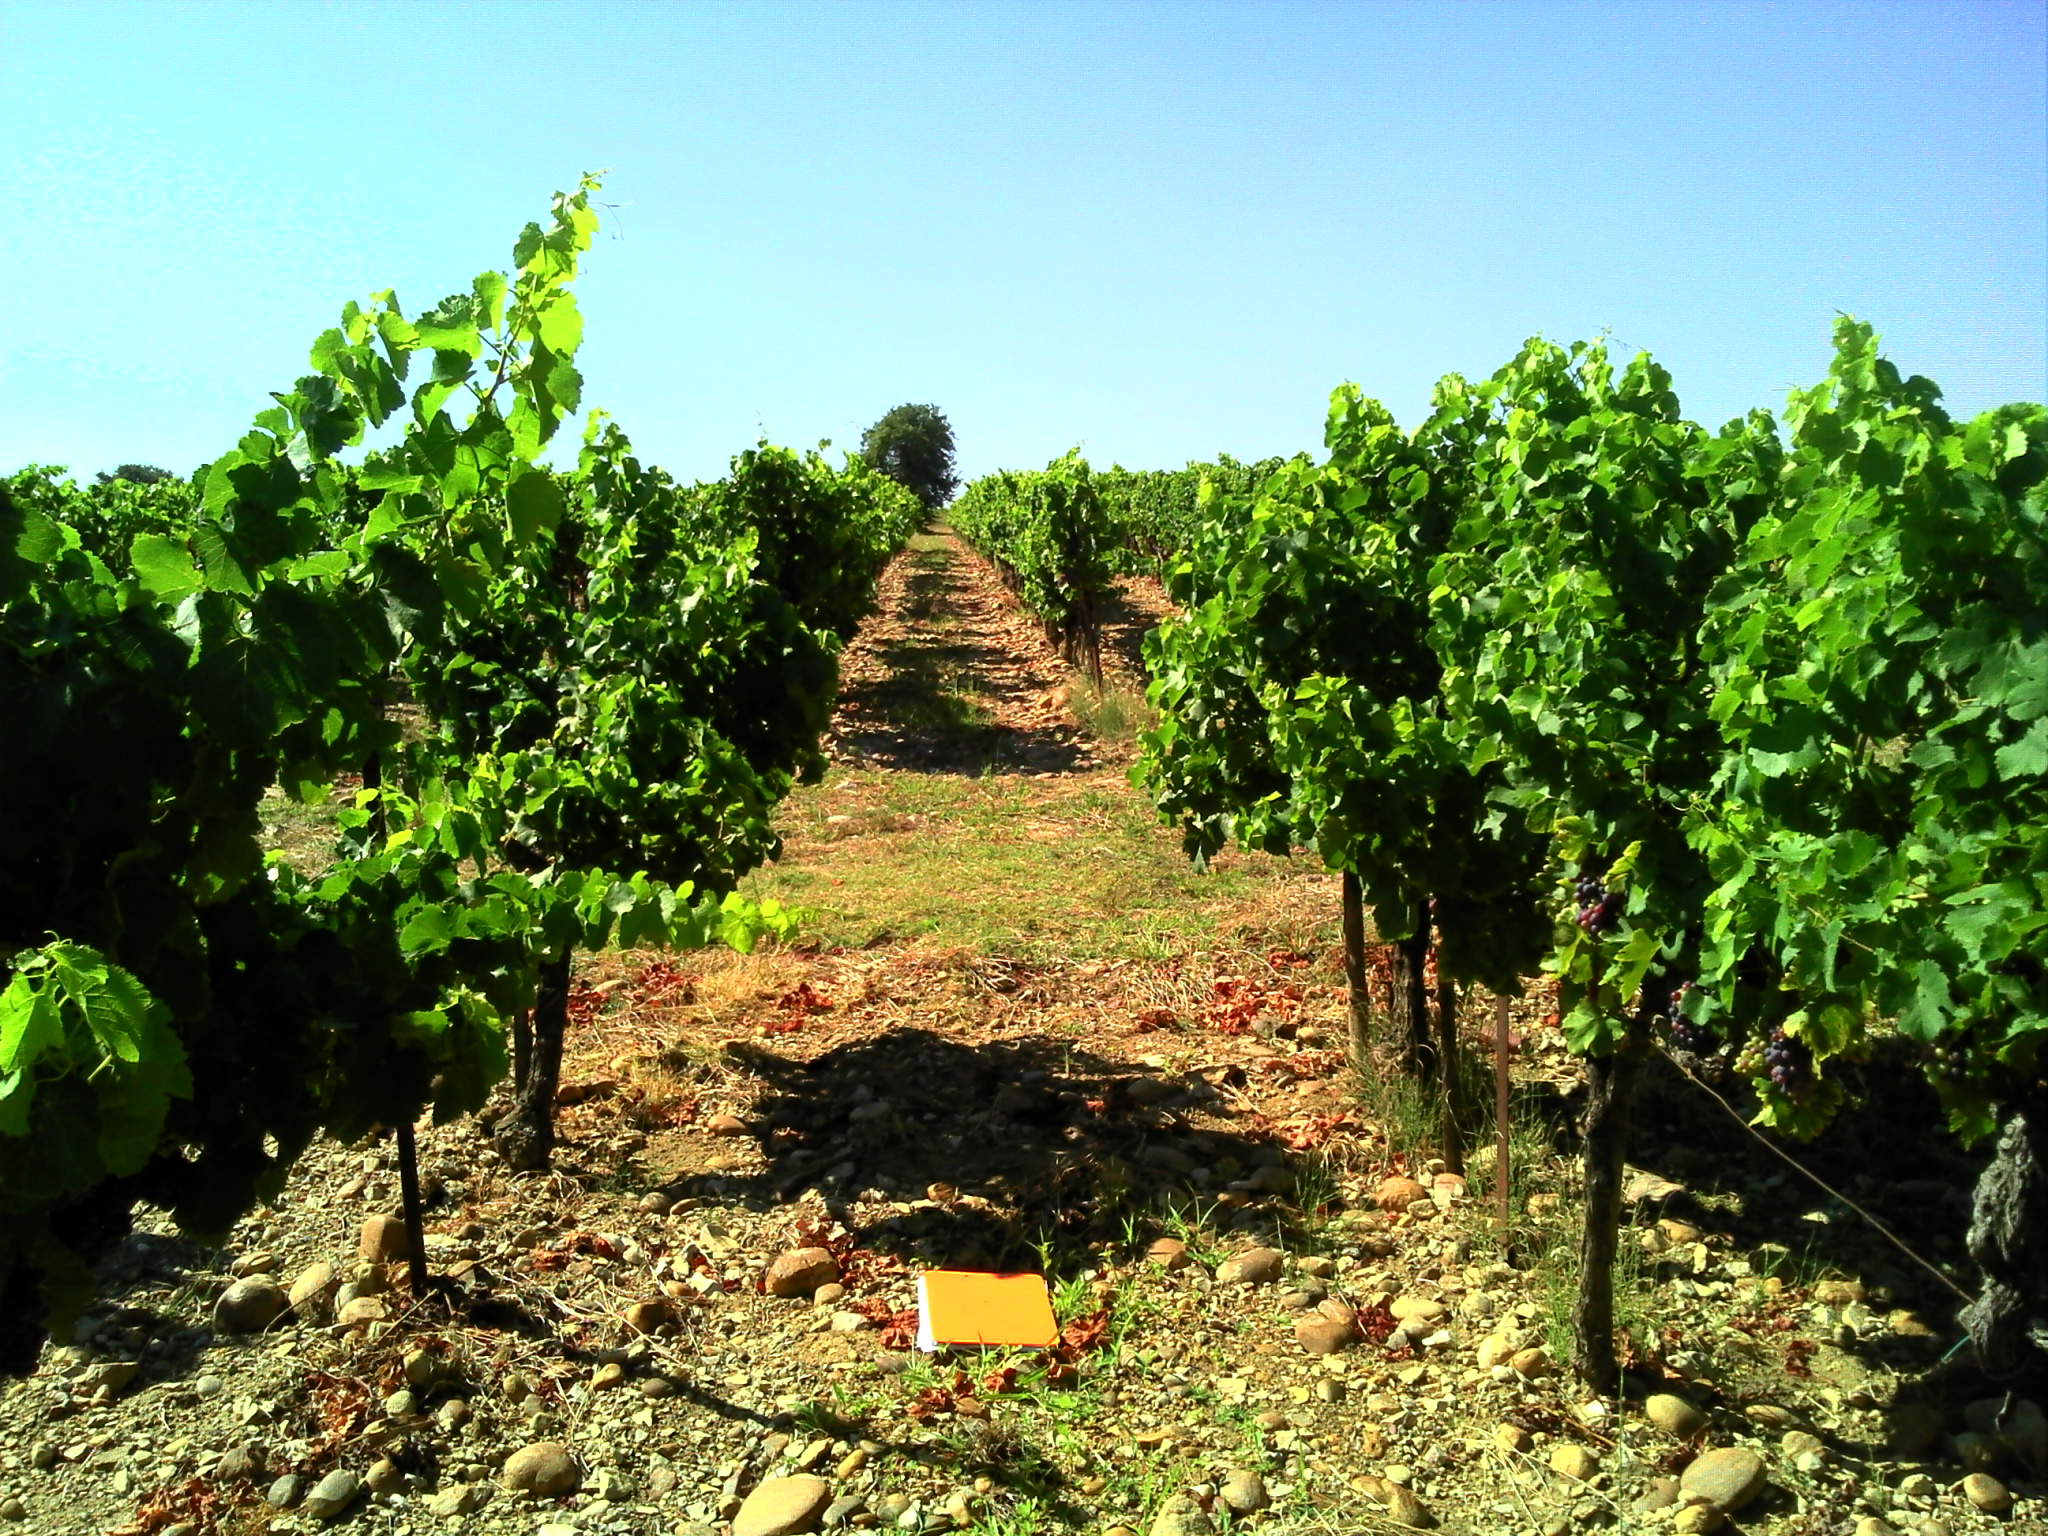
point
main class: Cropland
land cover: Vineyards
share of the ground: 25 - 50 %
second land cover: Other bare soil
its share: > 75 %
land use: Agriculture (excluding fallow land and kitchen gardens)
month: August
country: FR
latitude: 44.0706
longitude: 4.7017
